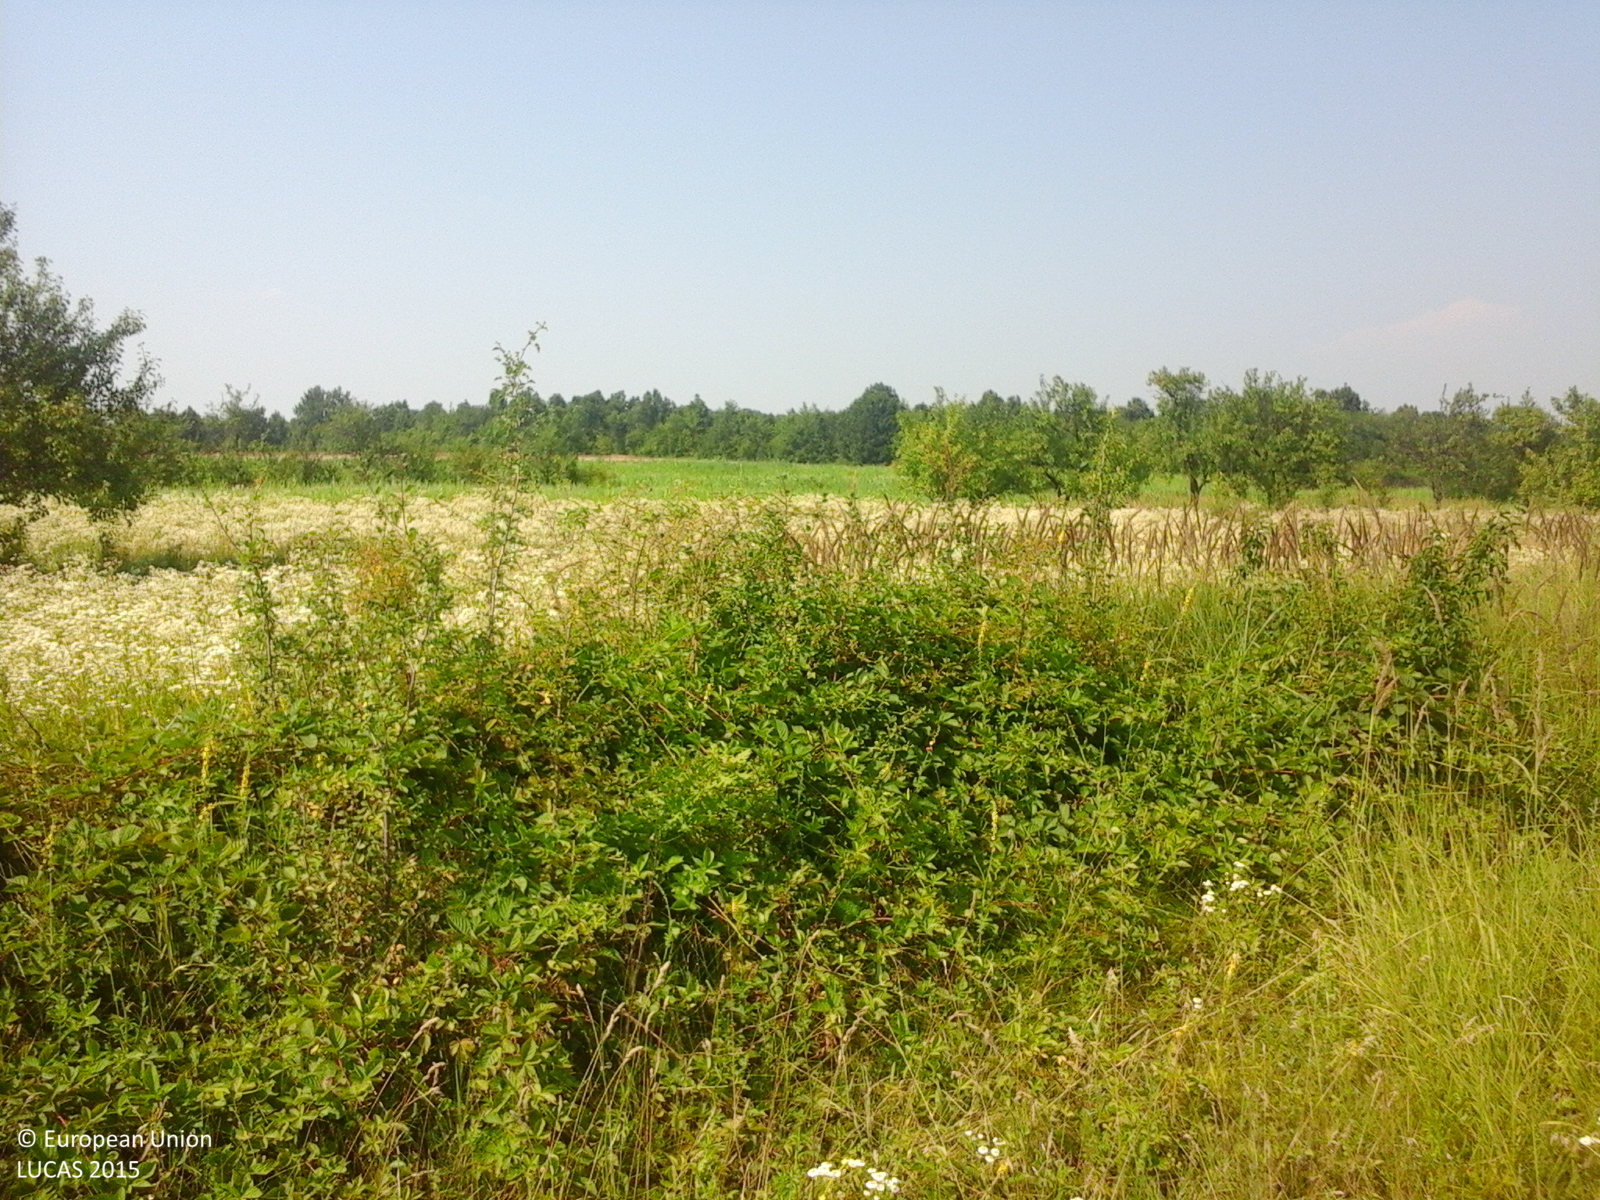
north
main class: Grassland
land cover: Grassland without tree/shrub cover
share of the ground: > 75 %
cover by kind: herbaceous plants 100 %
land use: Agriculture (excluding fallow land and kitchen gardens)
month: July
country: RO
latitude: 44.7990
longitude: 25.3240
